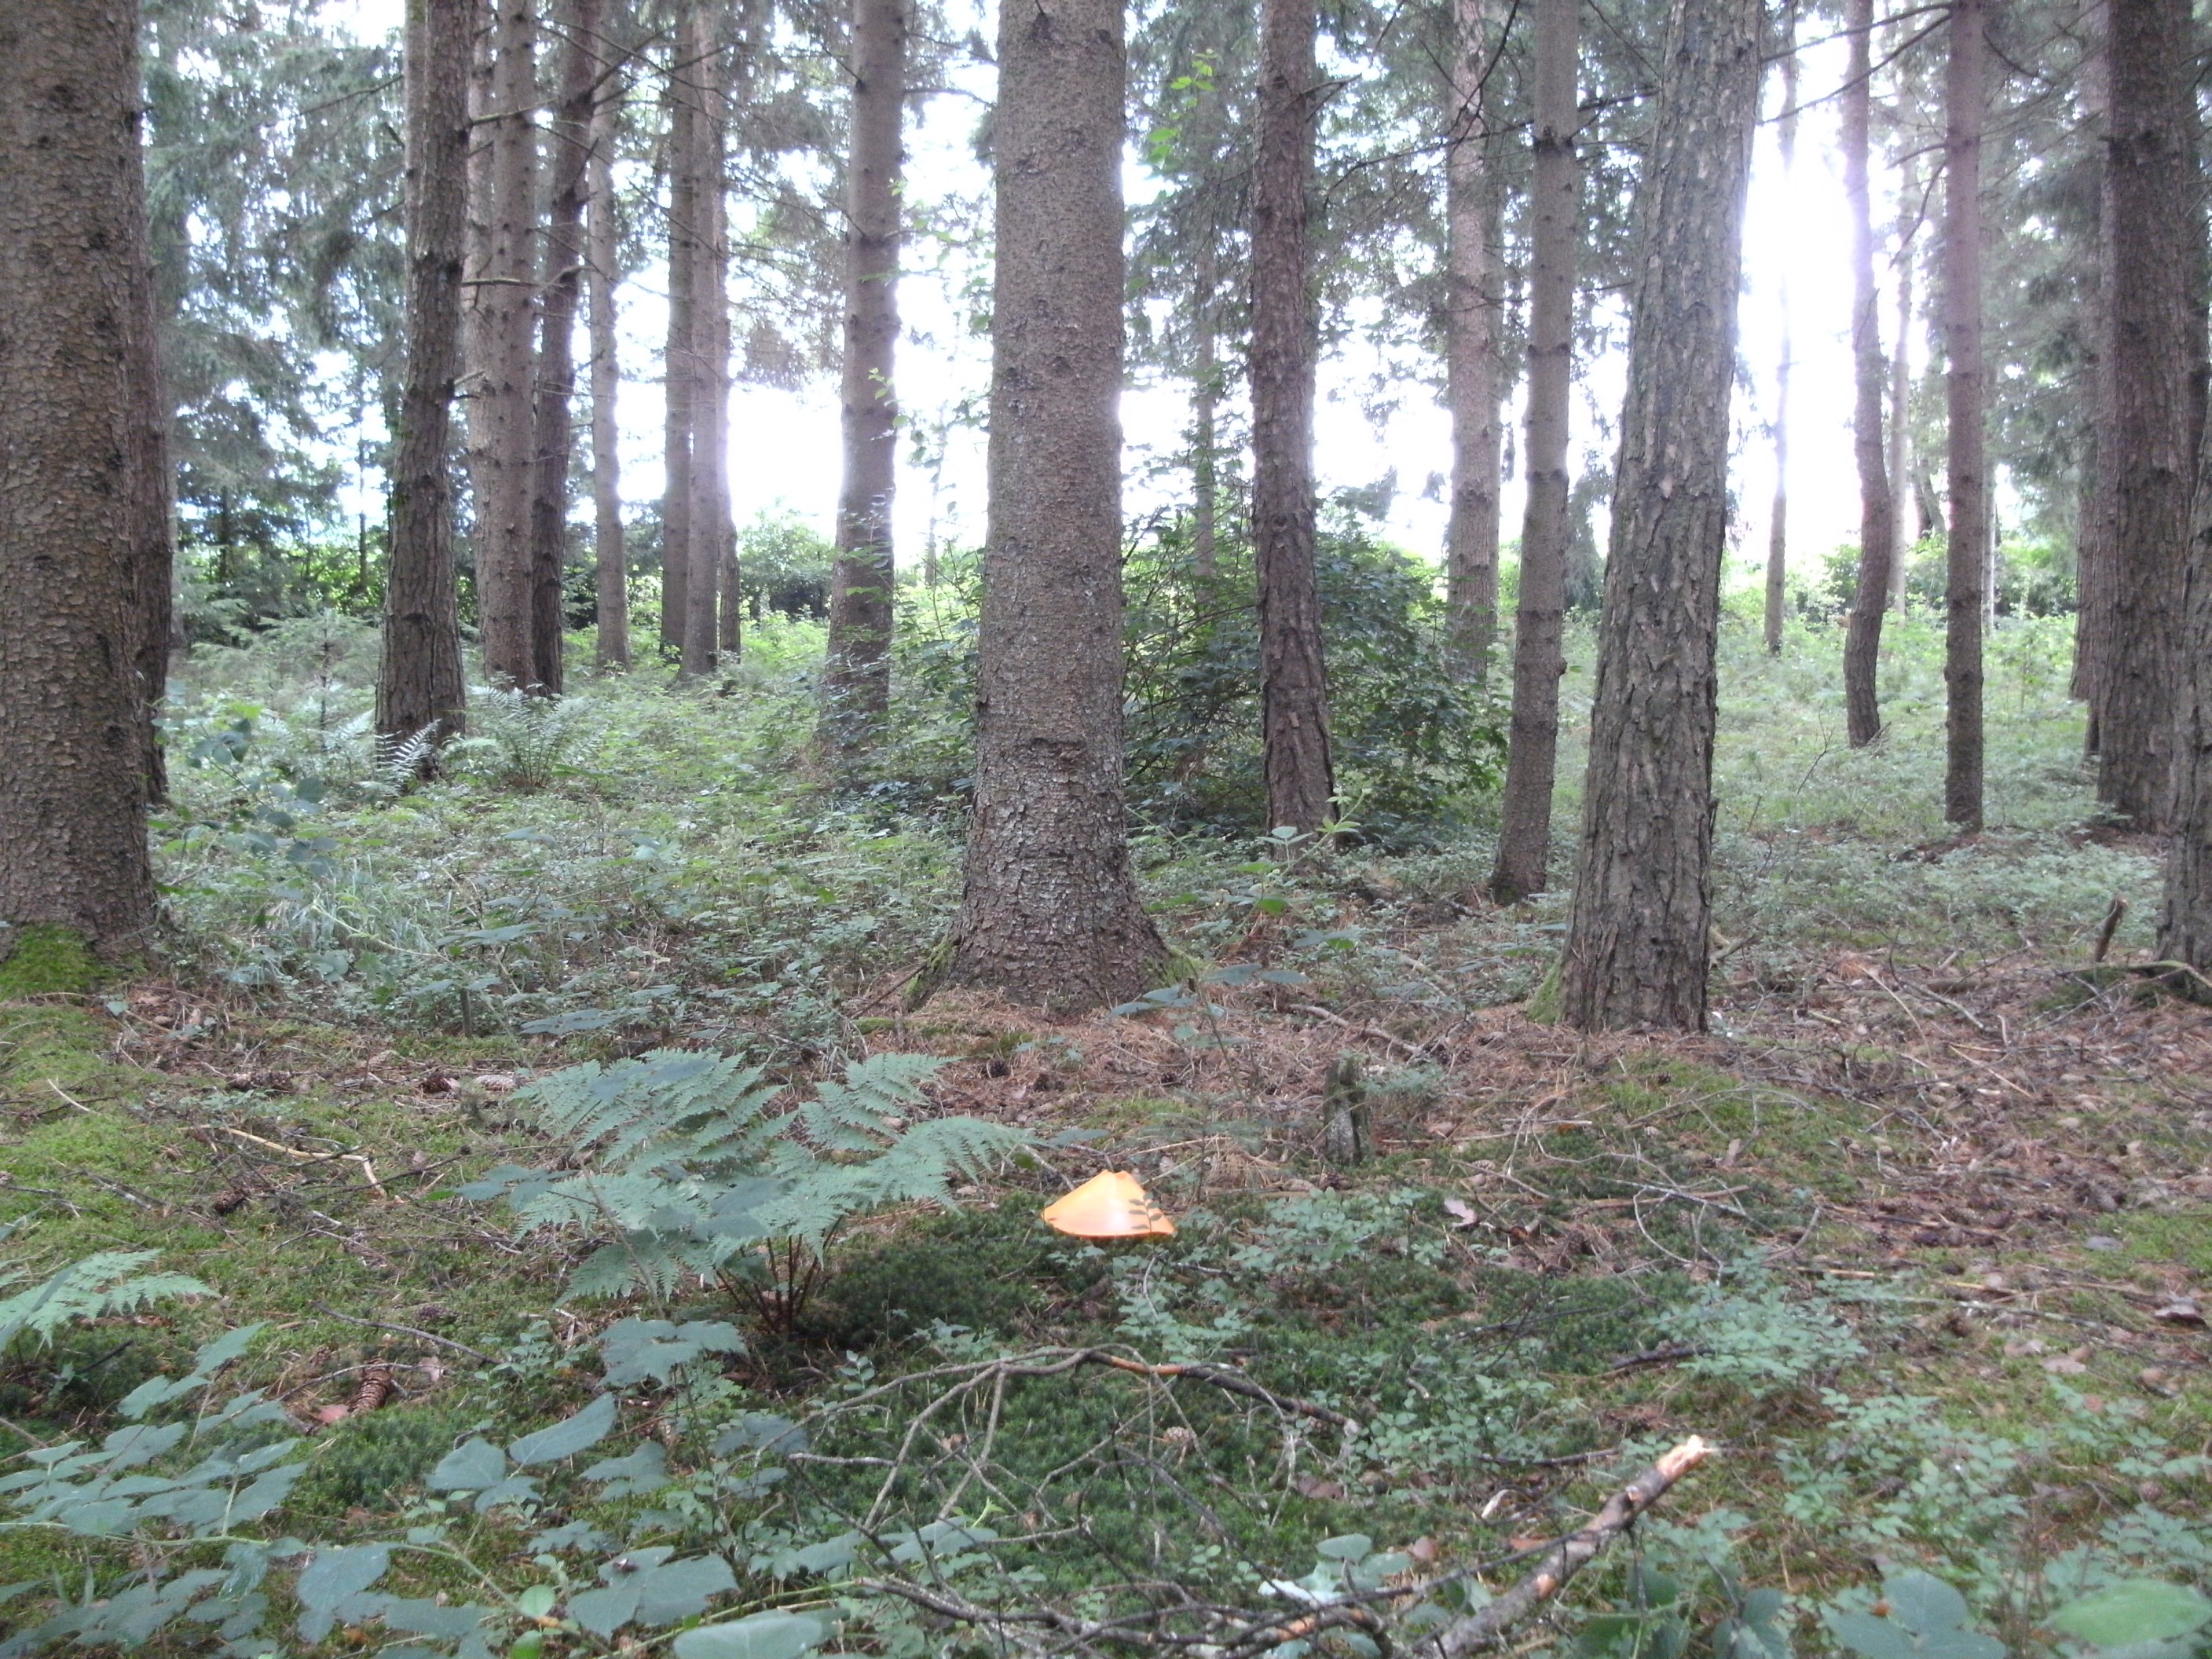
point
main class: Woodland
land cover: Other coniferous woodland
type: hemiboreal forest and nemoral coniferous forest and mixed broadleaved-coniferous forest
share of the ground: > 75 %
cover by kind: coniferous forest trees 85 %, shrubs 5 %, herbaceous plants 5 %, unconsolidated bare surface 5 %
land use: Forestry
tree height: > 5 m
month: July
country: AT
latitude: 46.6082
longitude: 14.7111
